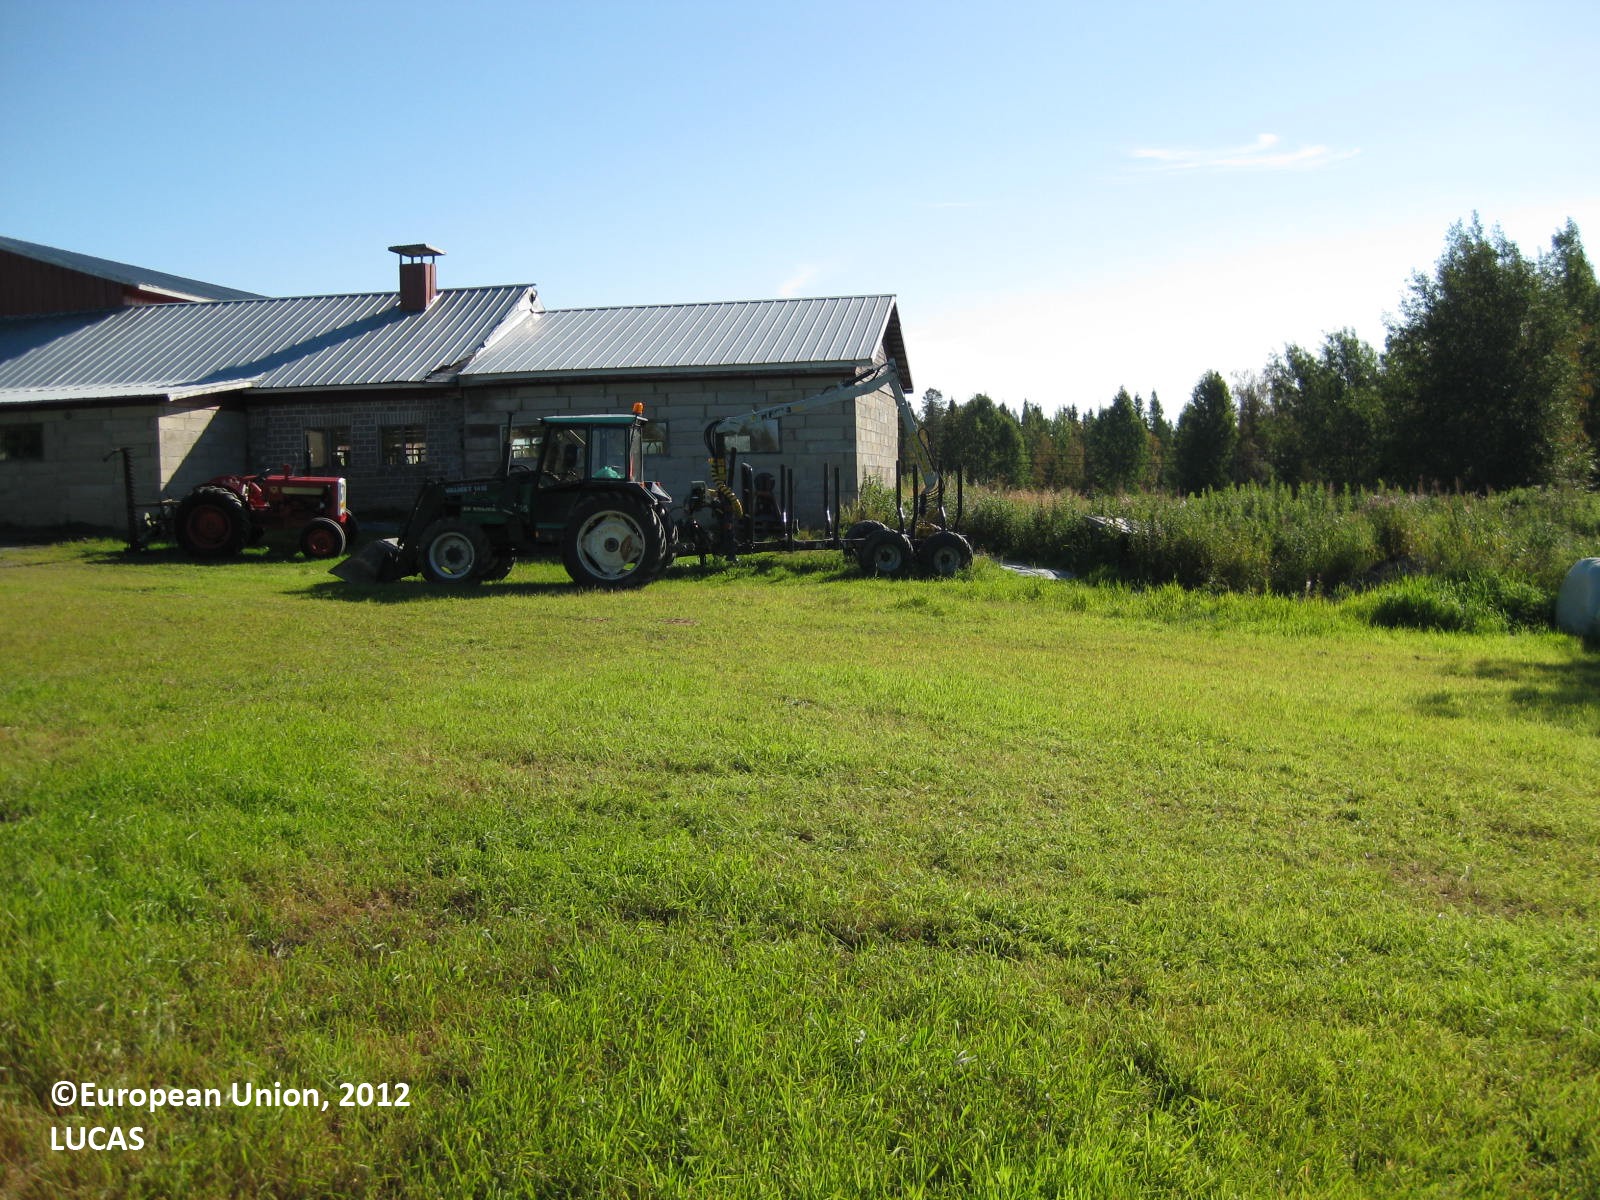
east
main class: Cropland
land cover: Temporary grasslands
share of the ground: > 75 %
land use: Agriculture (excluding fallow land and kitchen gardens)
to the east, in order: Temporary grasslands; Grass margins; Artificial constructions in urban areas; Grass margins; Temporary grasslands; Spontaneously vegetated surfaces; Barley; Paved roads, cycling and walking lanes; Barley; Spontaneously vegetated surfaces; Broadleaved woodland; Spontaneously vegetated surfaces; Artificial constructions in urban areas; Broadleaved woodland; Other coniferous woodland; Tracks; Other coniferous woodland
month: August
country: FI
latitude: 66.0815
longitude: 29.6230
